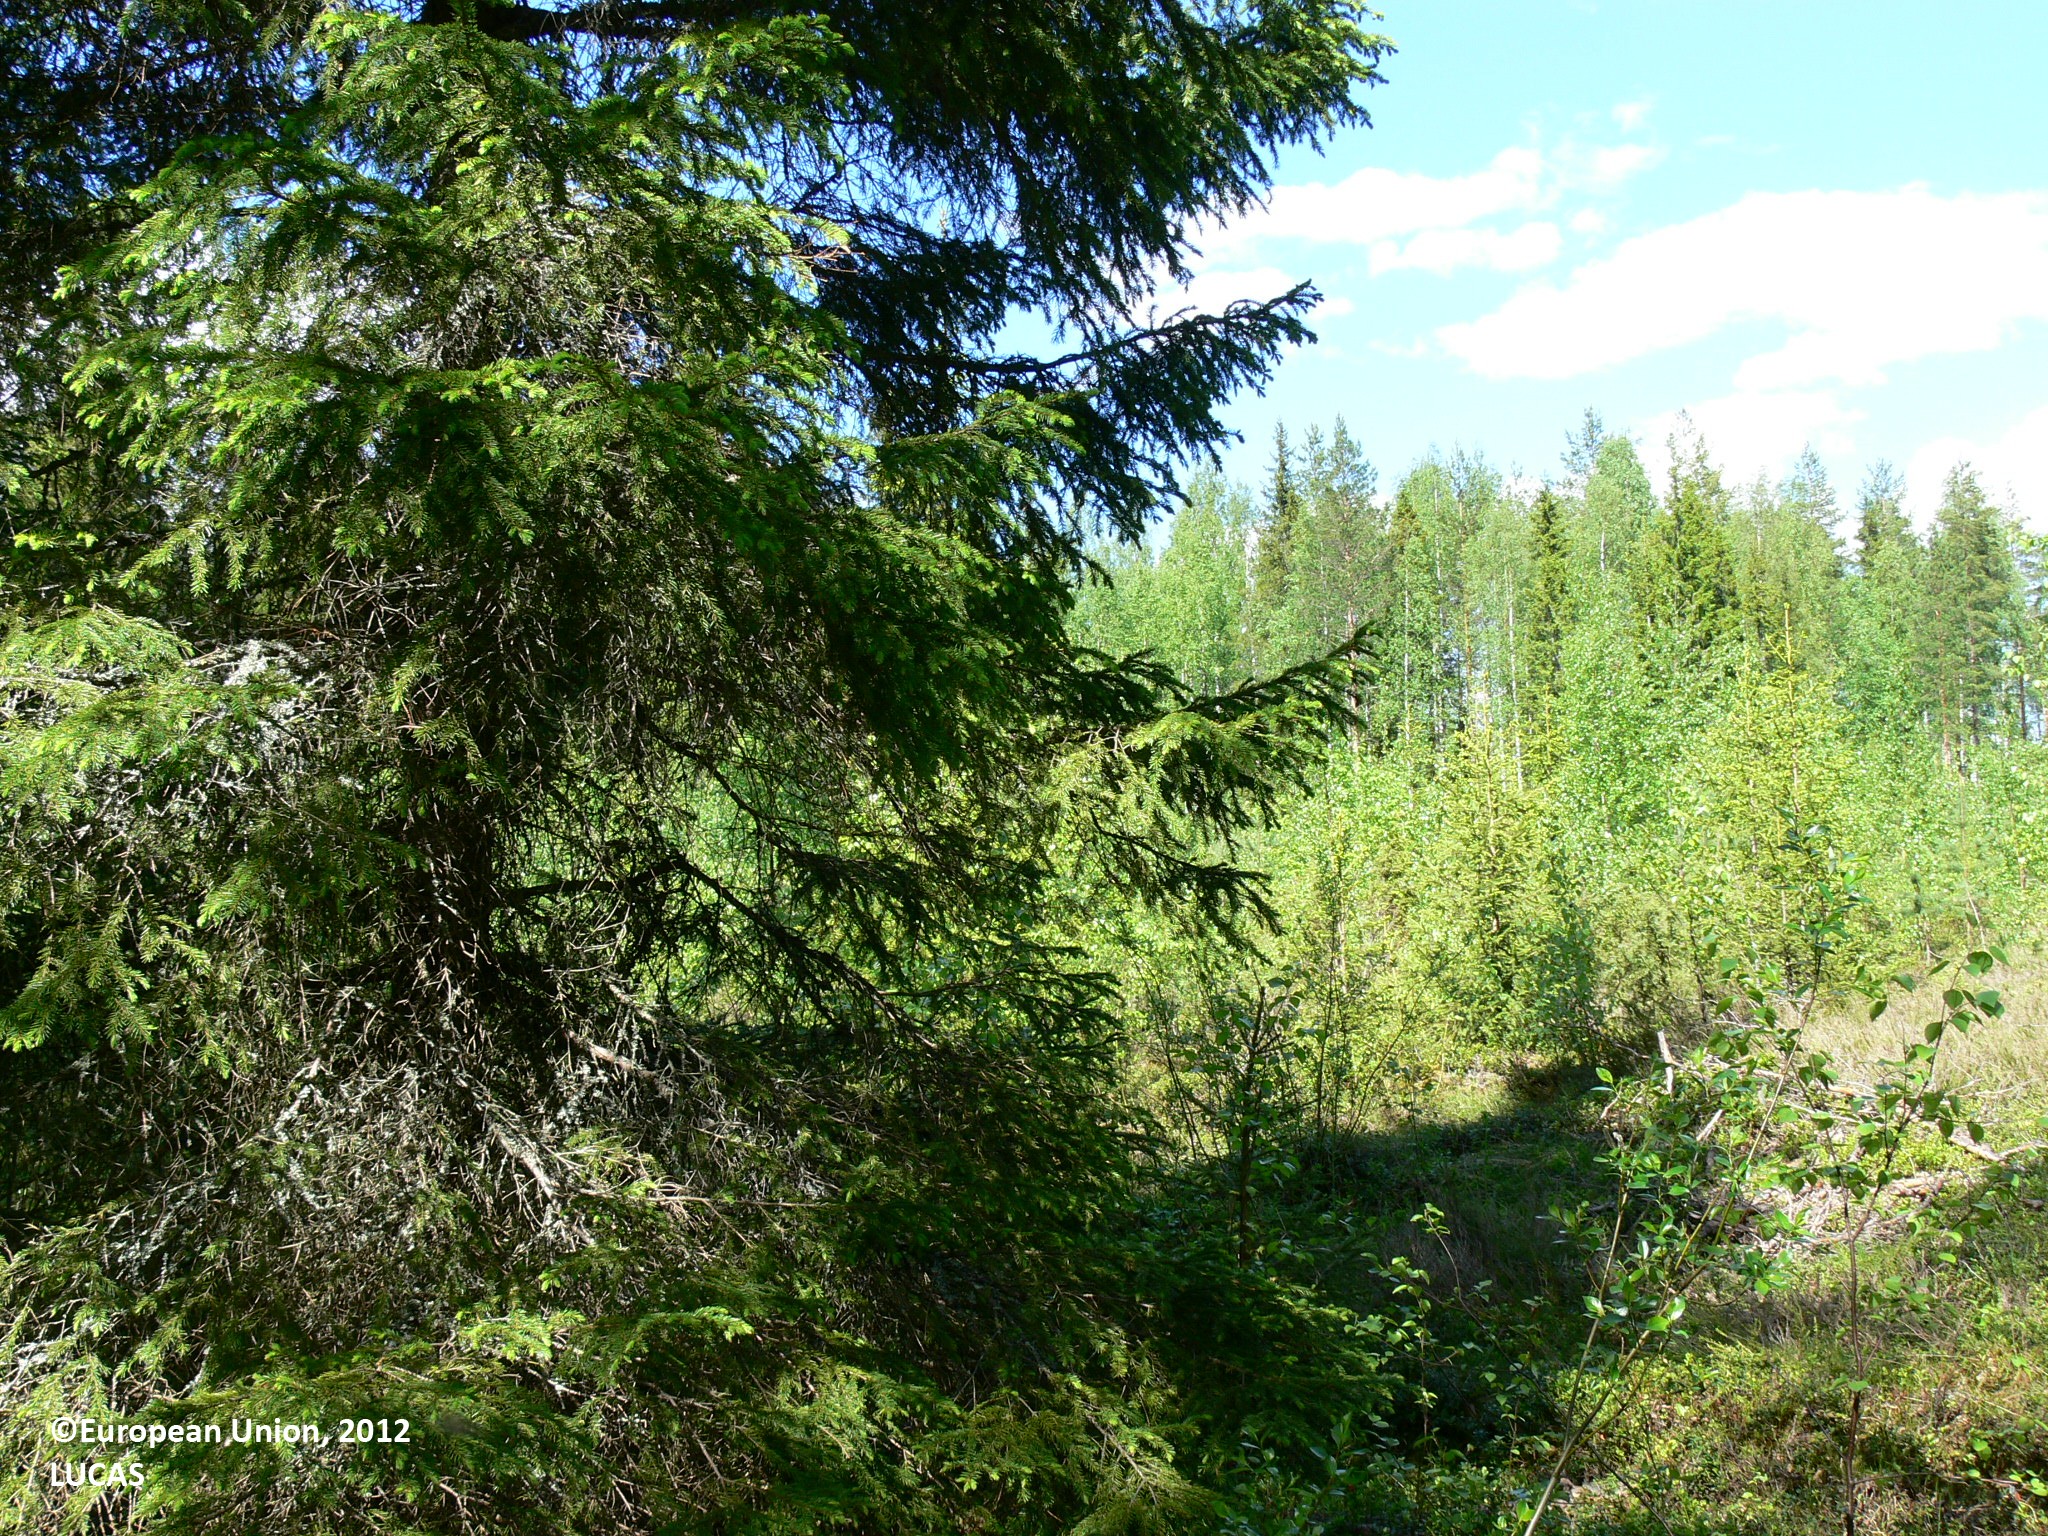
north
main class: Woodland
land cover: Other mixed woodland
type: boreal forest
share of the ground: > 75 %
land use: Forestry
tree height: > 5 m
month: June
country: FI
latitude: 62.5961
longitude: 30.8027
